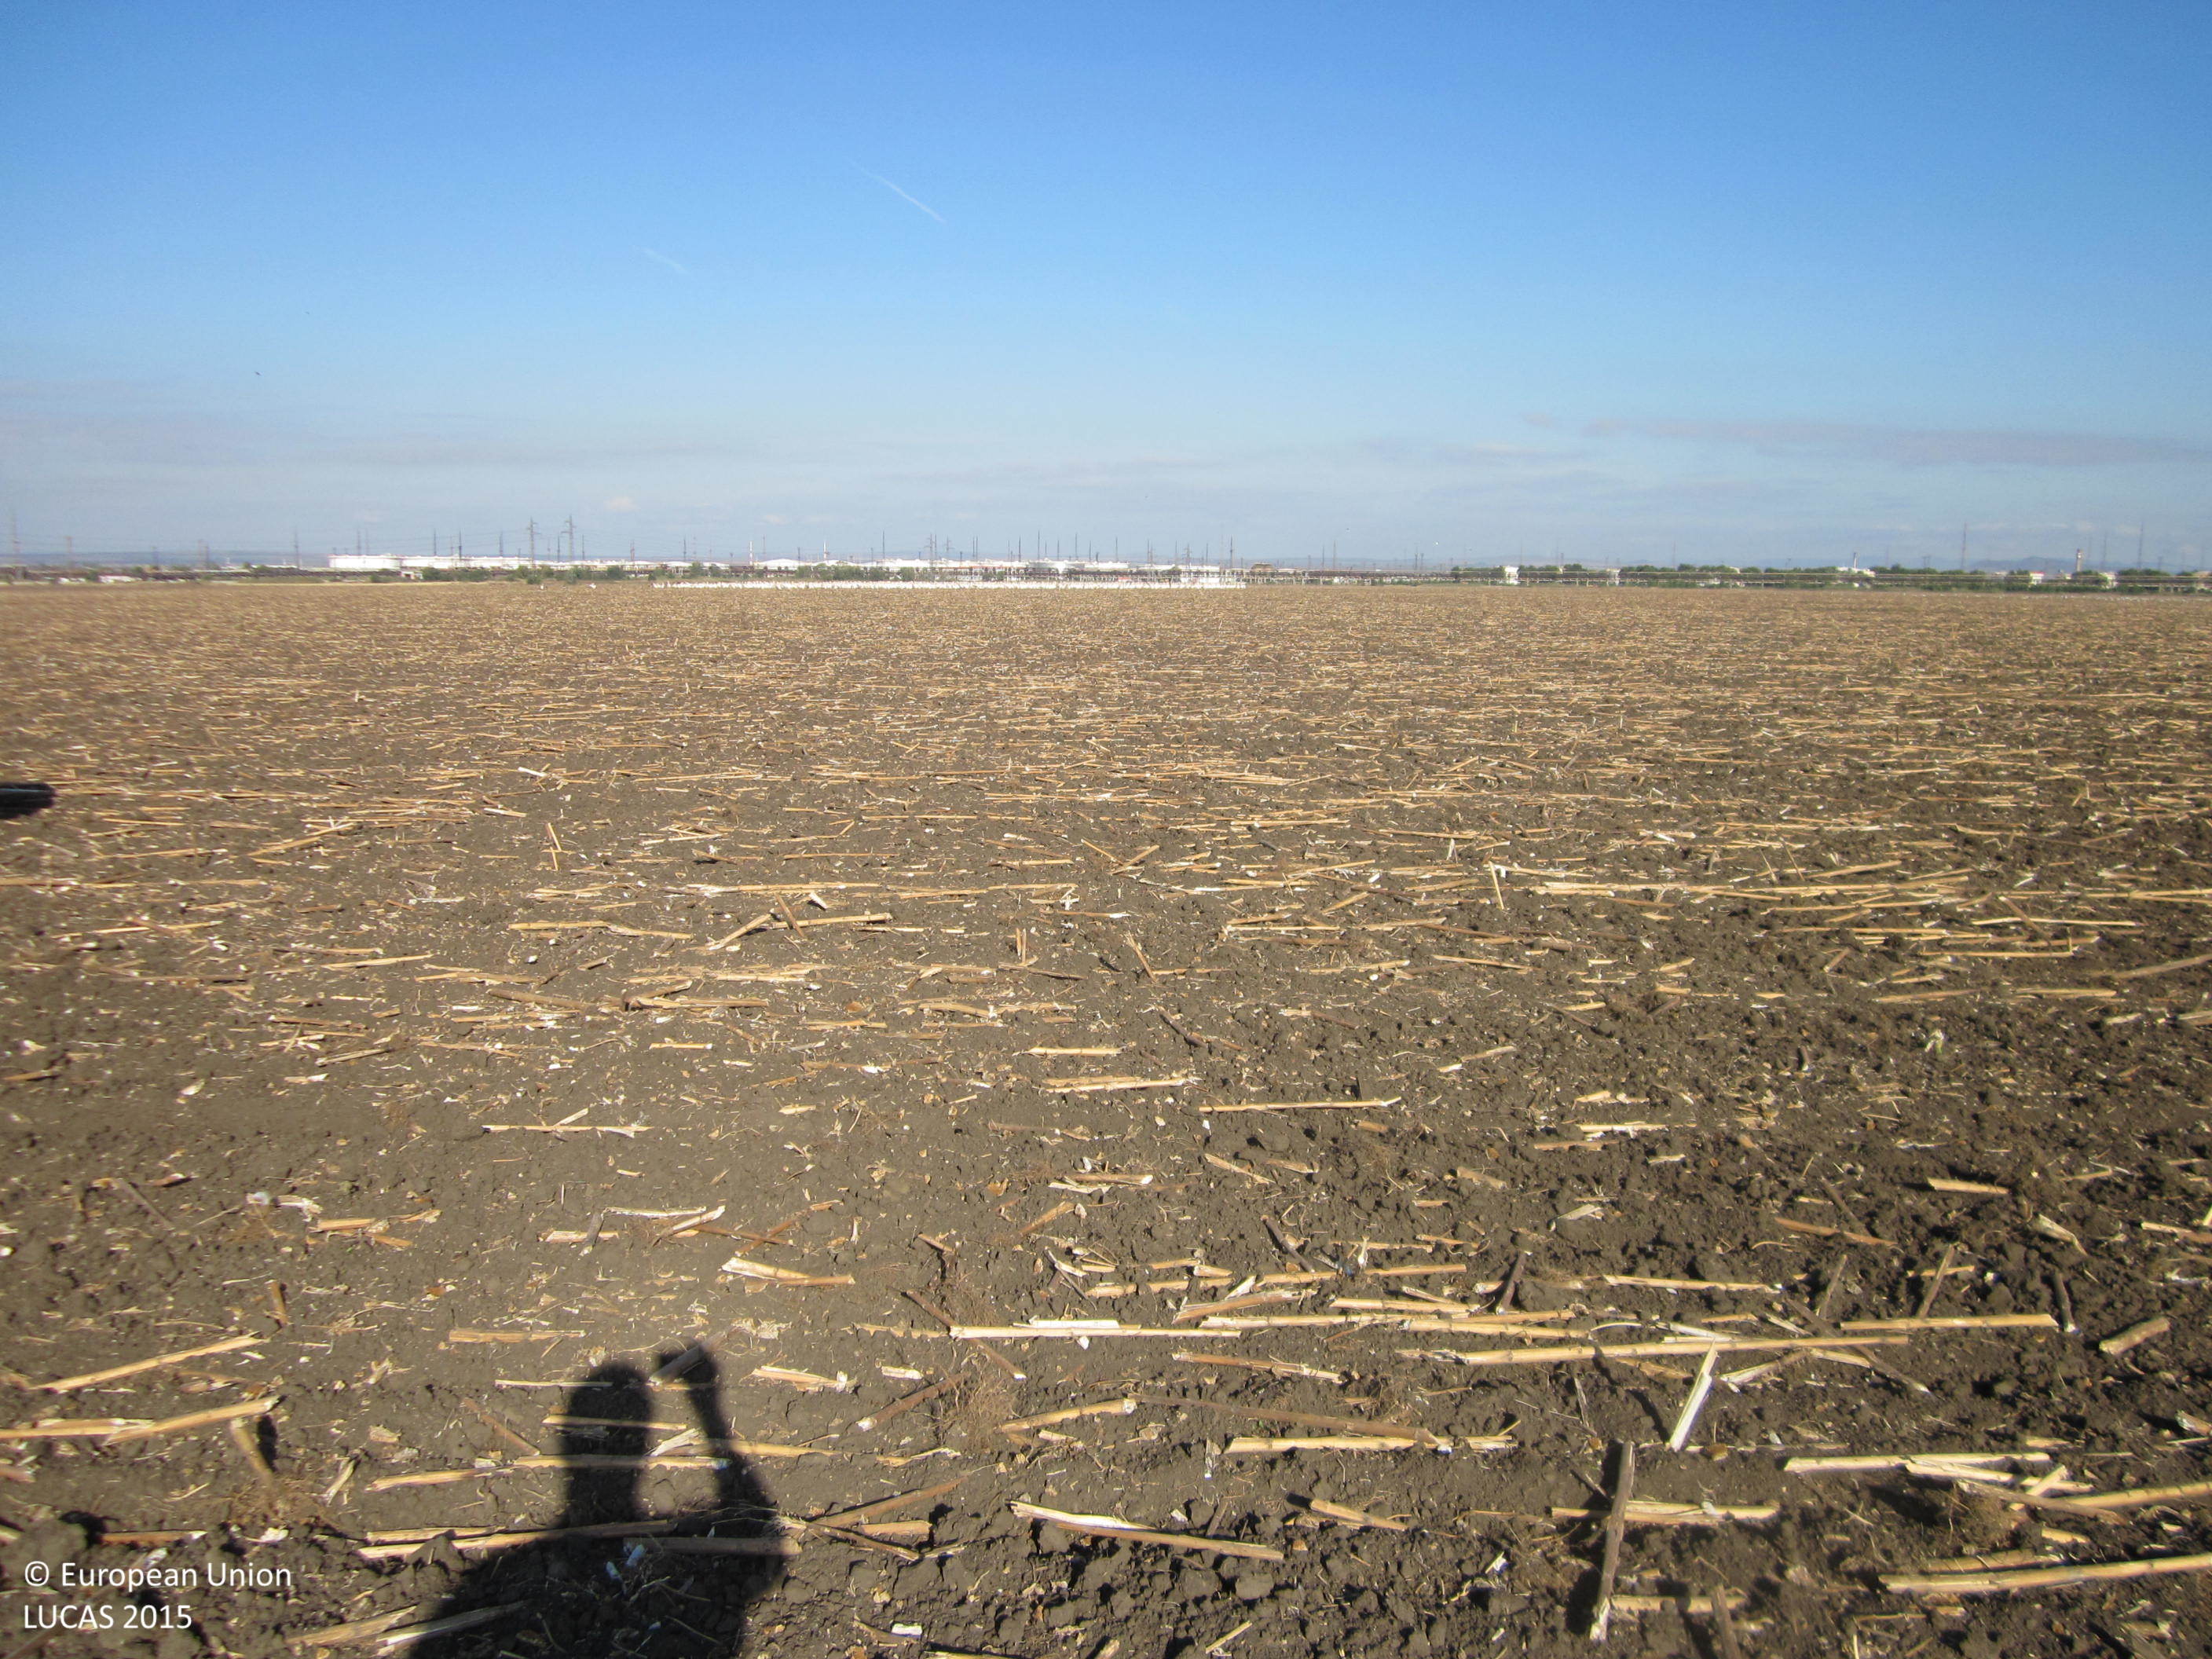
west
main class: Cropland
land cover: Sunflower
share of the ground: < 10 %
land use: Agriculture (excluding fallow land and kitchen gardens)
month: September
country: BG
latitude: 42.5270
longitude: 27.3397
